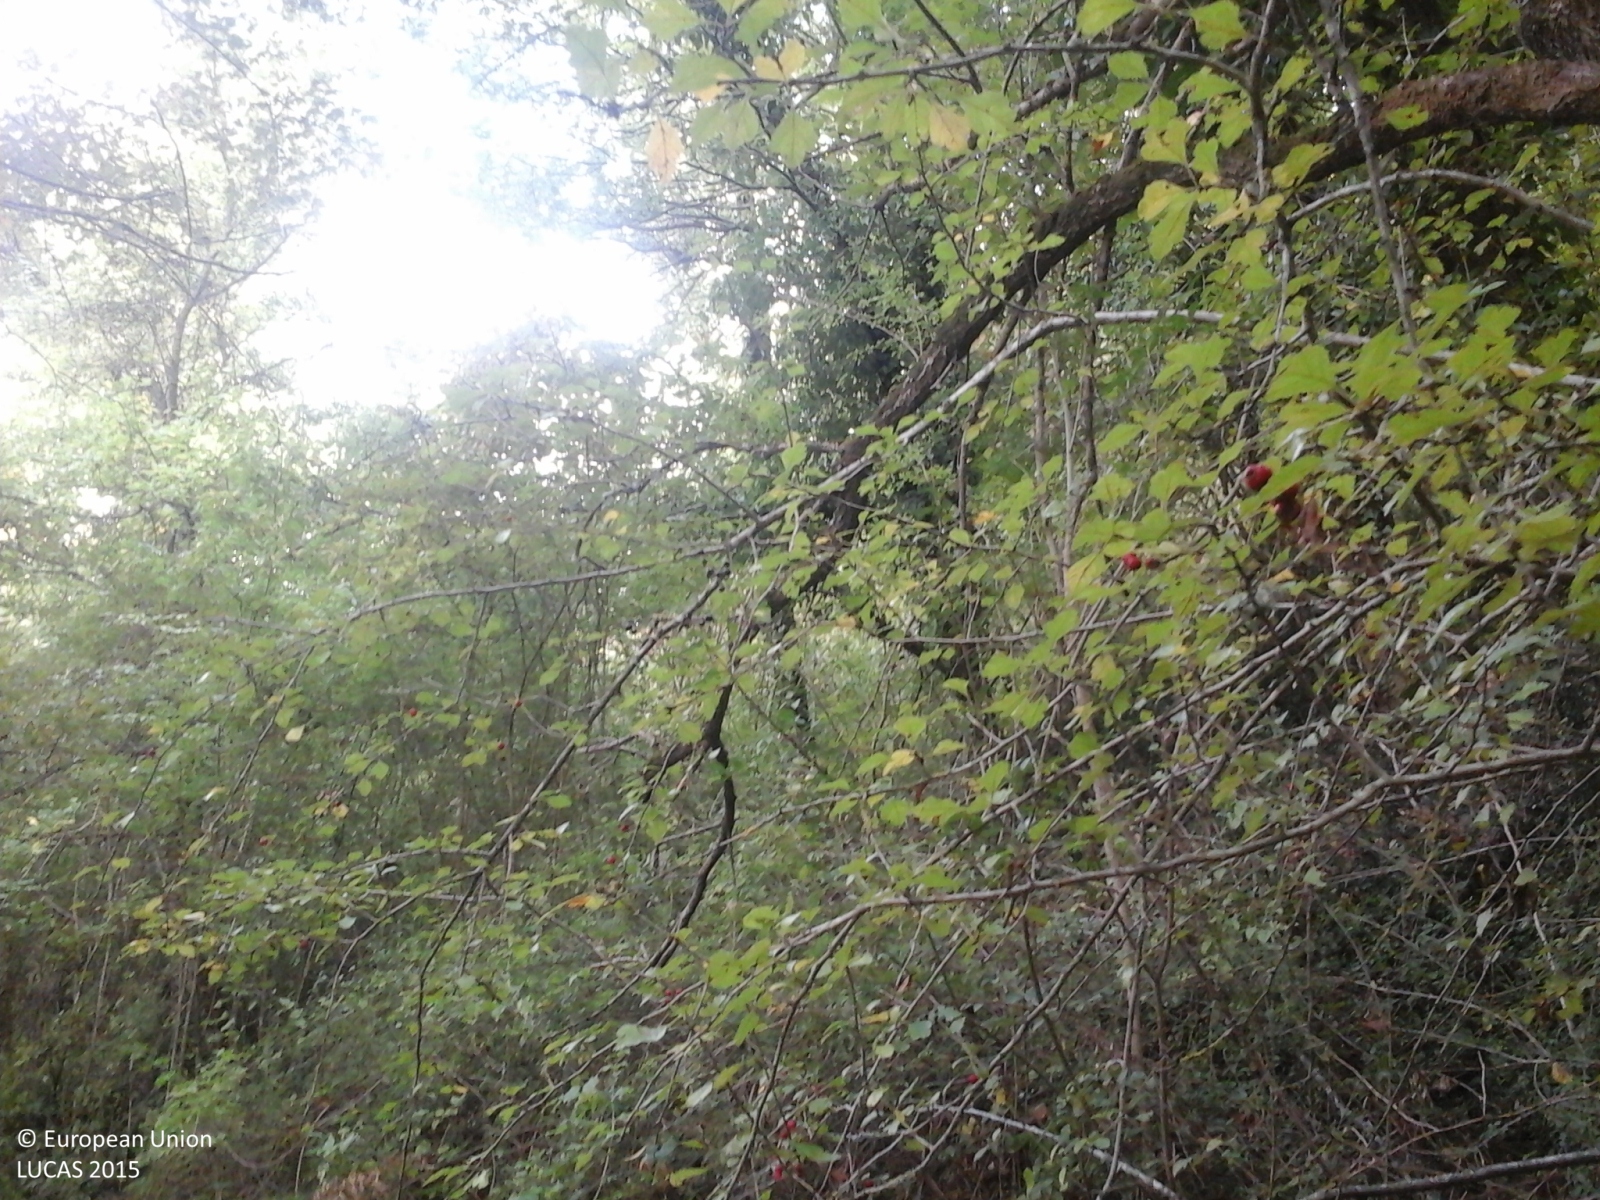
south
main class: Woodland
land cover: Broadleaved woodland
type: thermophilous deciduous forest
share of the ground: > 75 %
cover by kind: broadleaved forest trees 70 %, shrubs 30 %
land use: Forestry
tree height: > 5 m
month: October
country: IT
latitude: 43.4247
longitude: 12.2050
